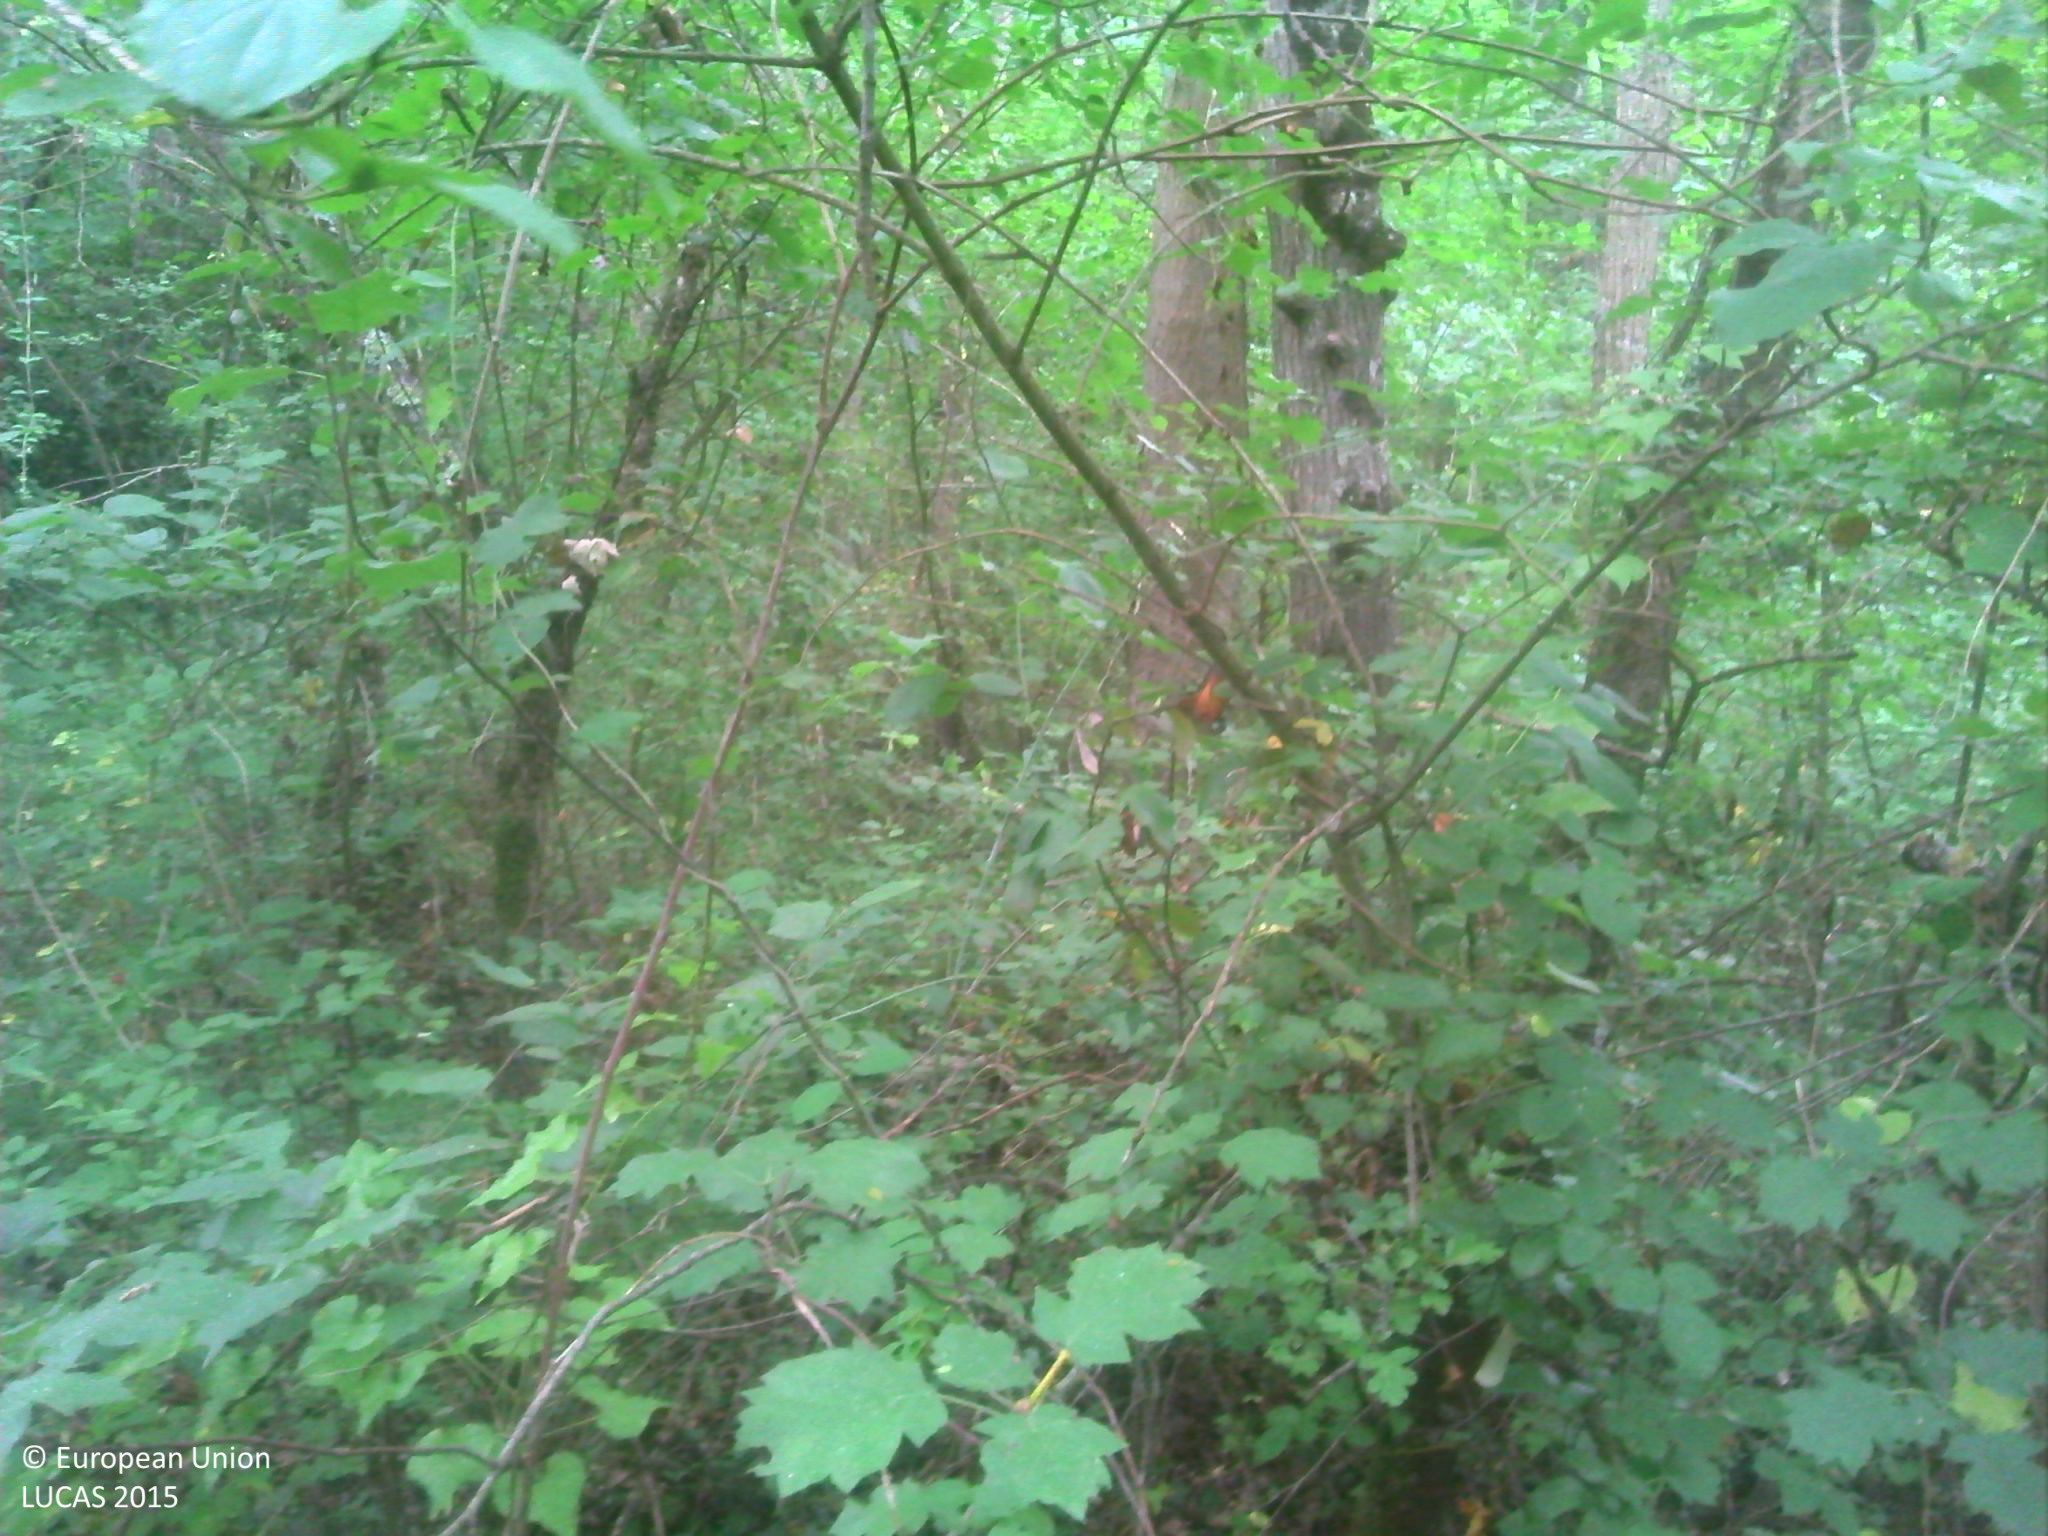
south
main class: Woodland
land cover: Broadleaved woodland
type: acidophilous oak and oak-birch forest
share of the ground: > 75 %
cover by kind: broadleaved forest trees 60 %, shrubs 30 %, herbaceous plants 10 %
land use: Forestry
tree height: > 5 m
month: July
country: FR
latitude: 43.2910
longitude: 1.4632
